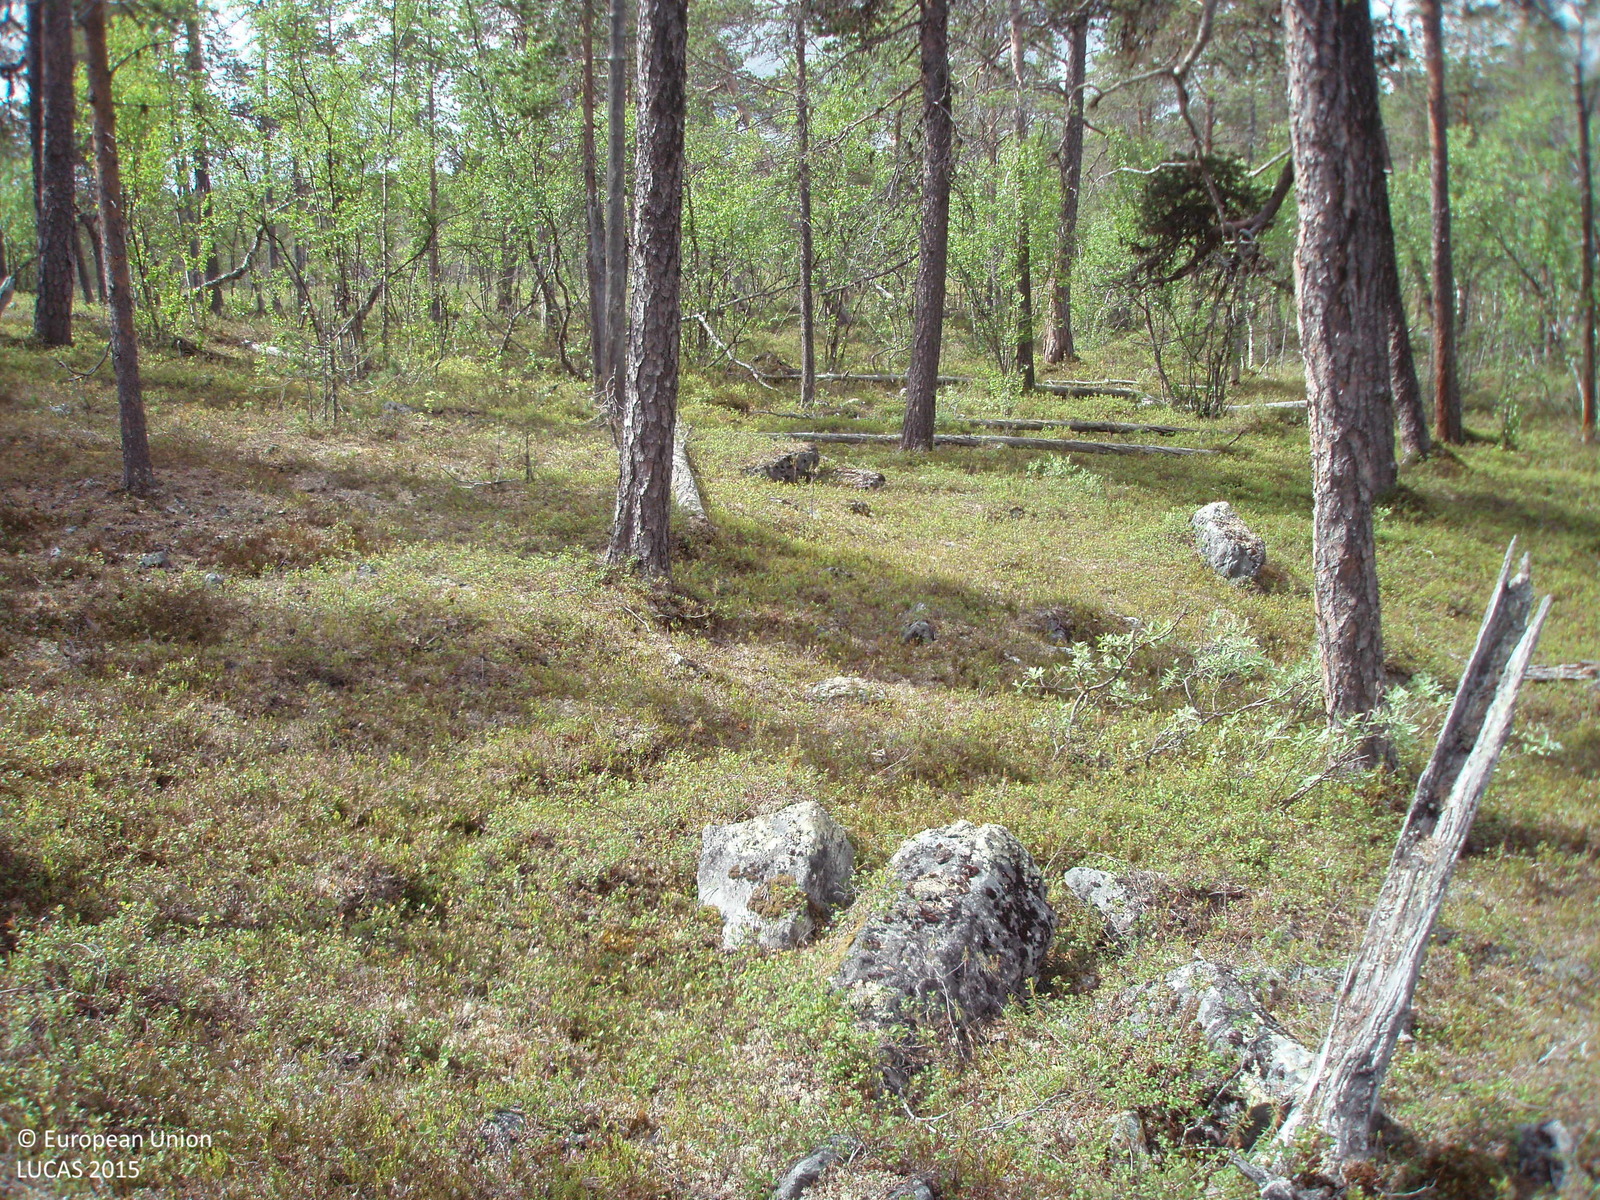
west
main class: Woodland
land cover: Pine dominated coniferous woodland
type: boreal forest
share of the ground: 50 - 75 %
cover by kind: coniferous forest trees 50 %, shrubs 35 %, broadleaved forest trees 5 %, lichens and mosses 5 %, unconsolidated bare surface 5 %
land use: Forestry
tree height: > 5 m
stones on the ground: > 50 %
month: July
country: FI
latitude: 68.8866
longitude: 25.8292
